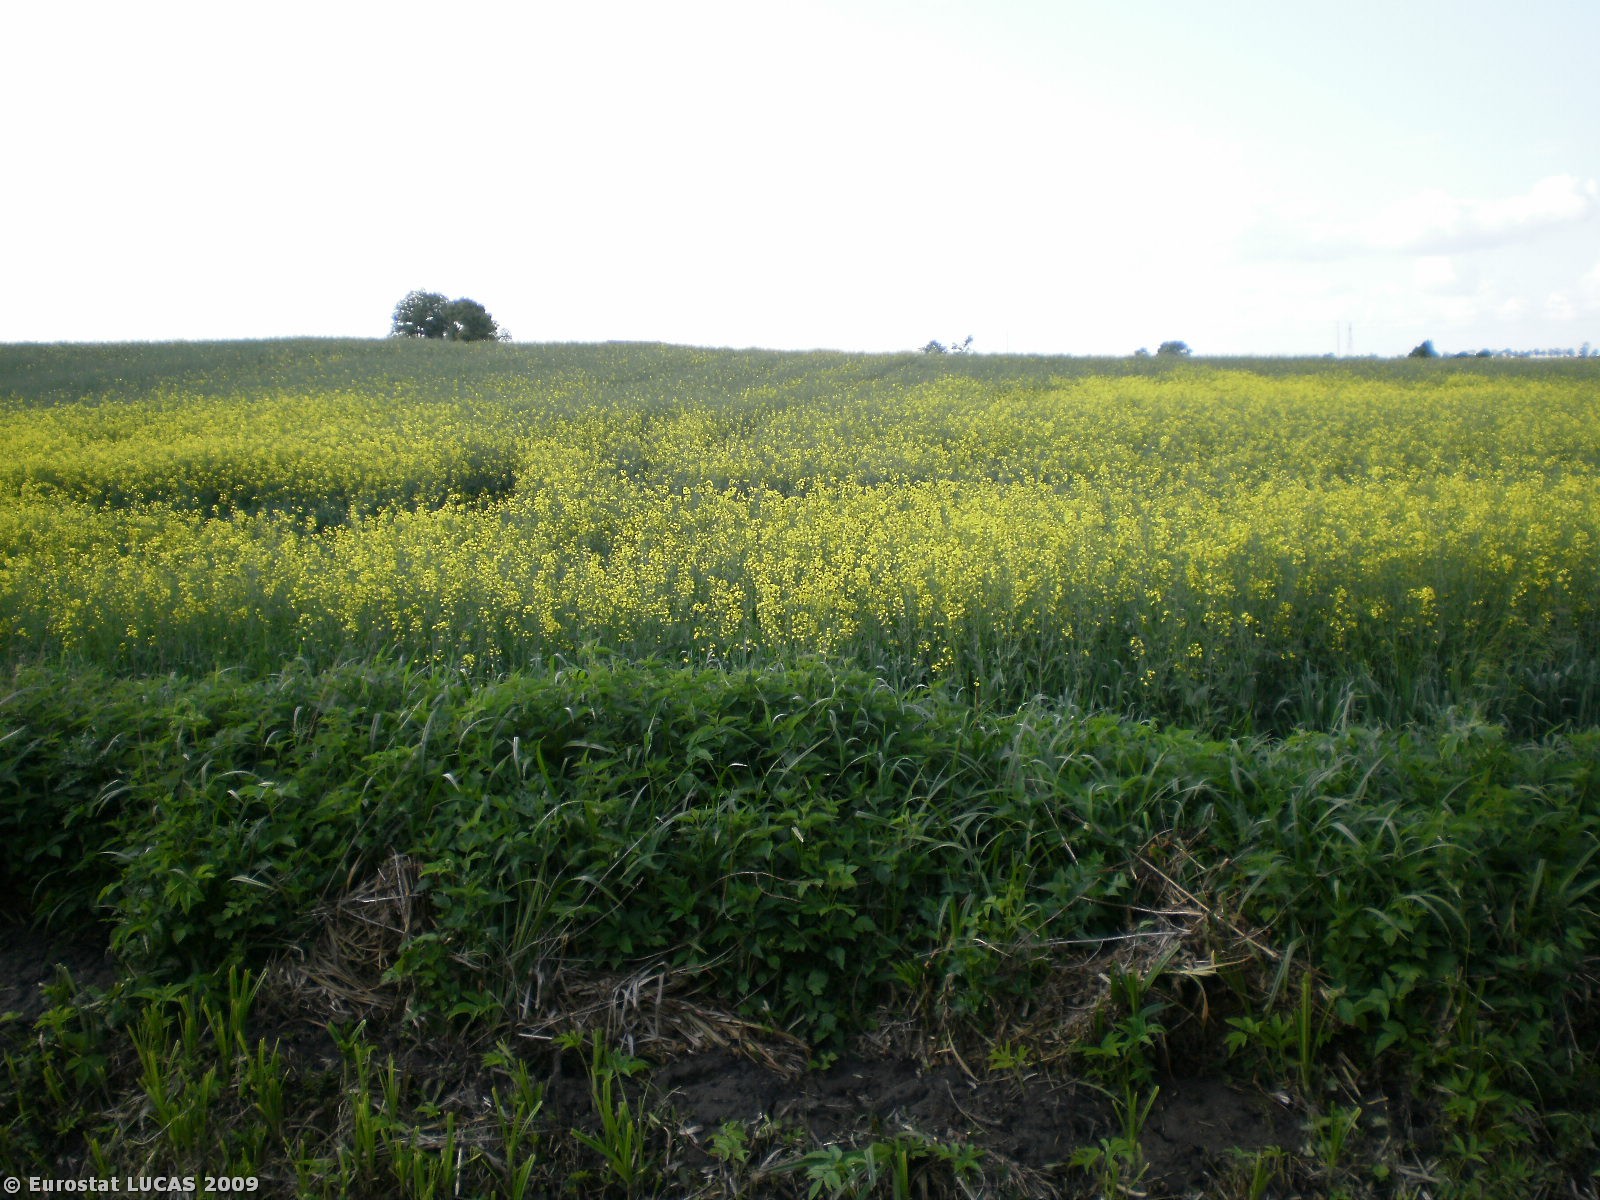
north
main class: Cropland
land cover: Rape and turnip rape
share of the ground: > 75 %
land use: Agriculture (excluding fallow land and kitchen gardens)
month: May
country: PL
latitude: 53.3361
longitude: 17.7172
